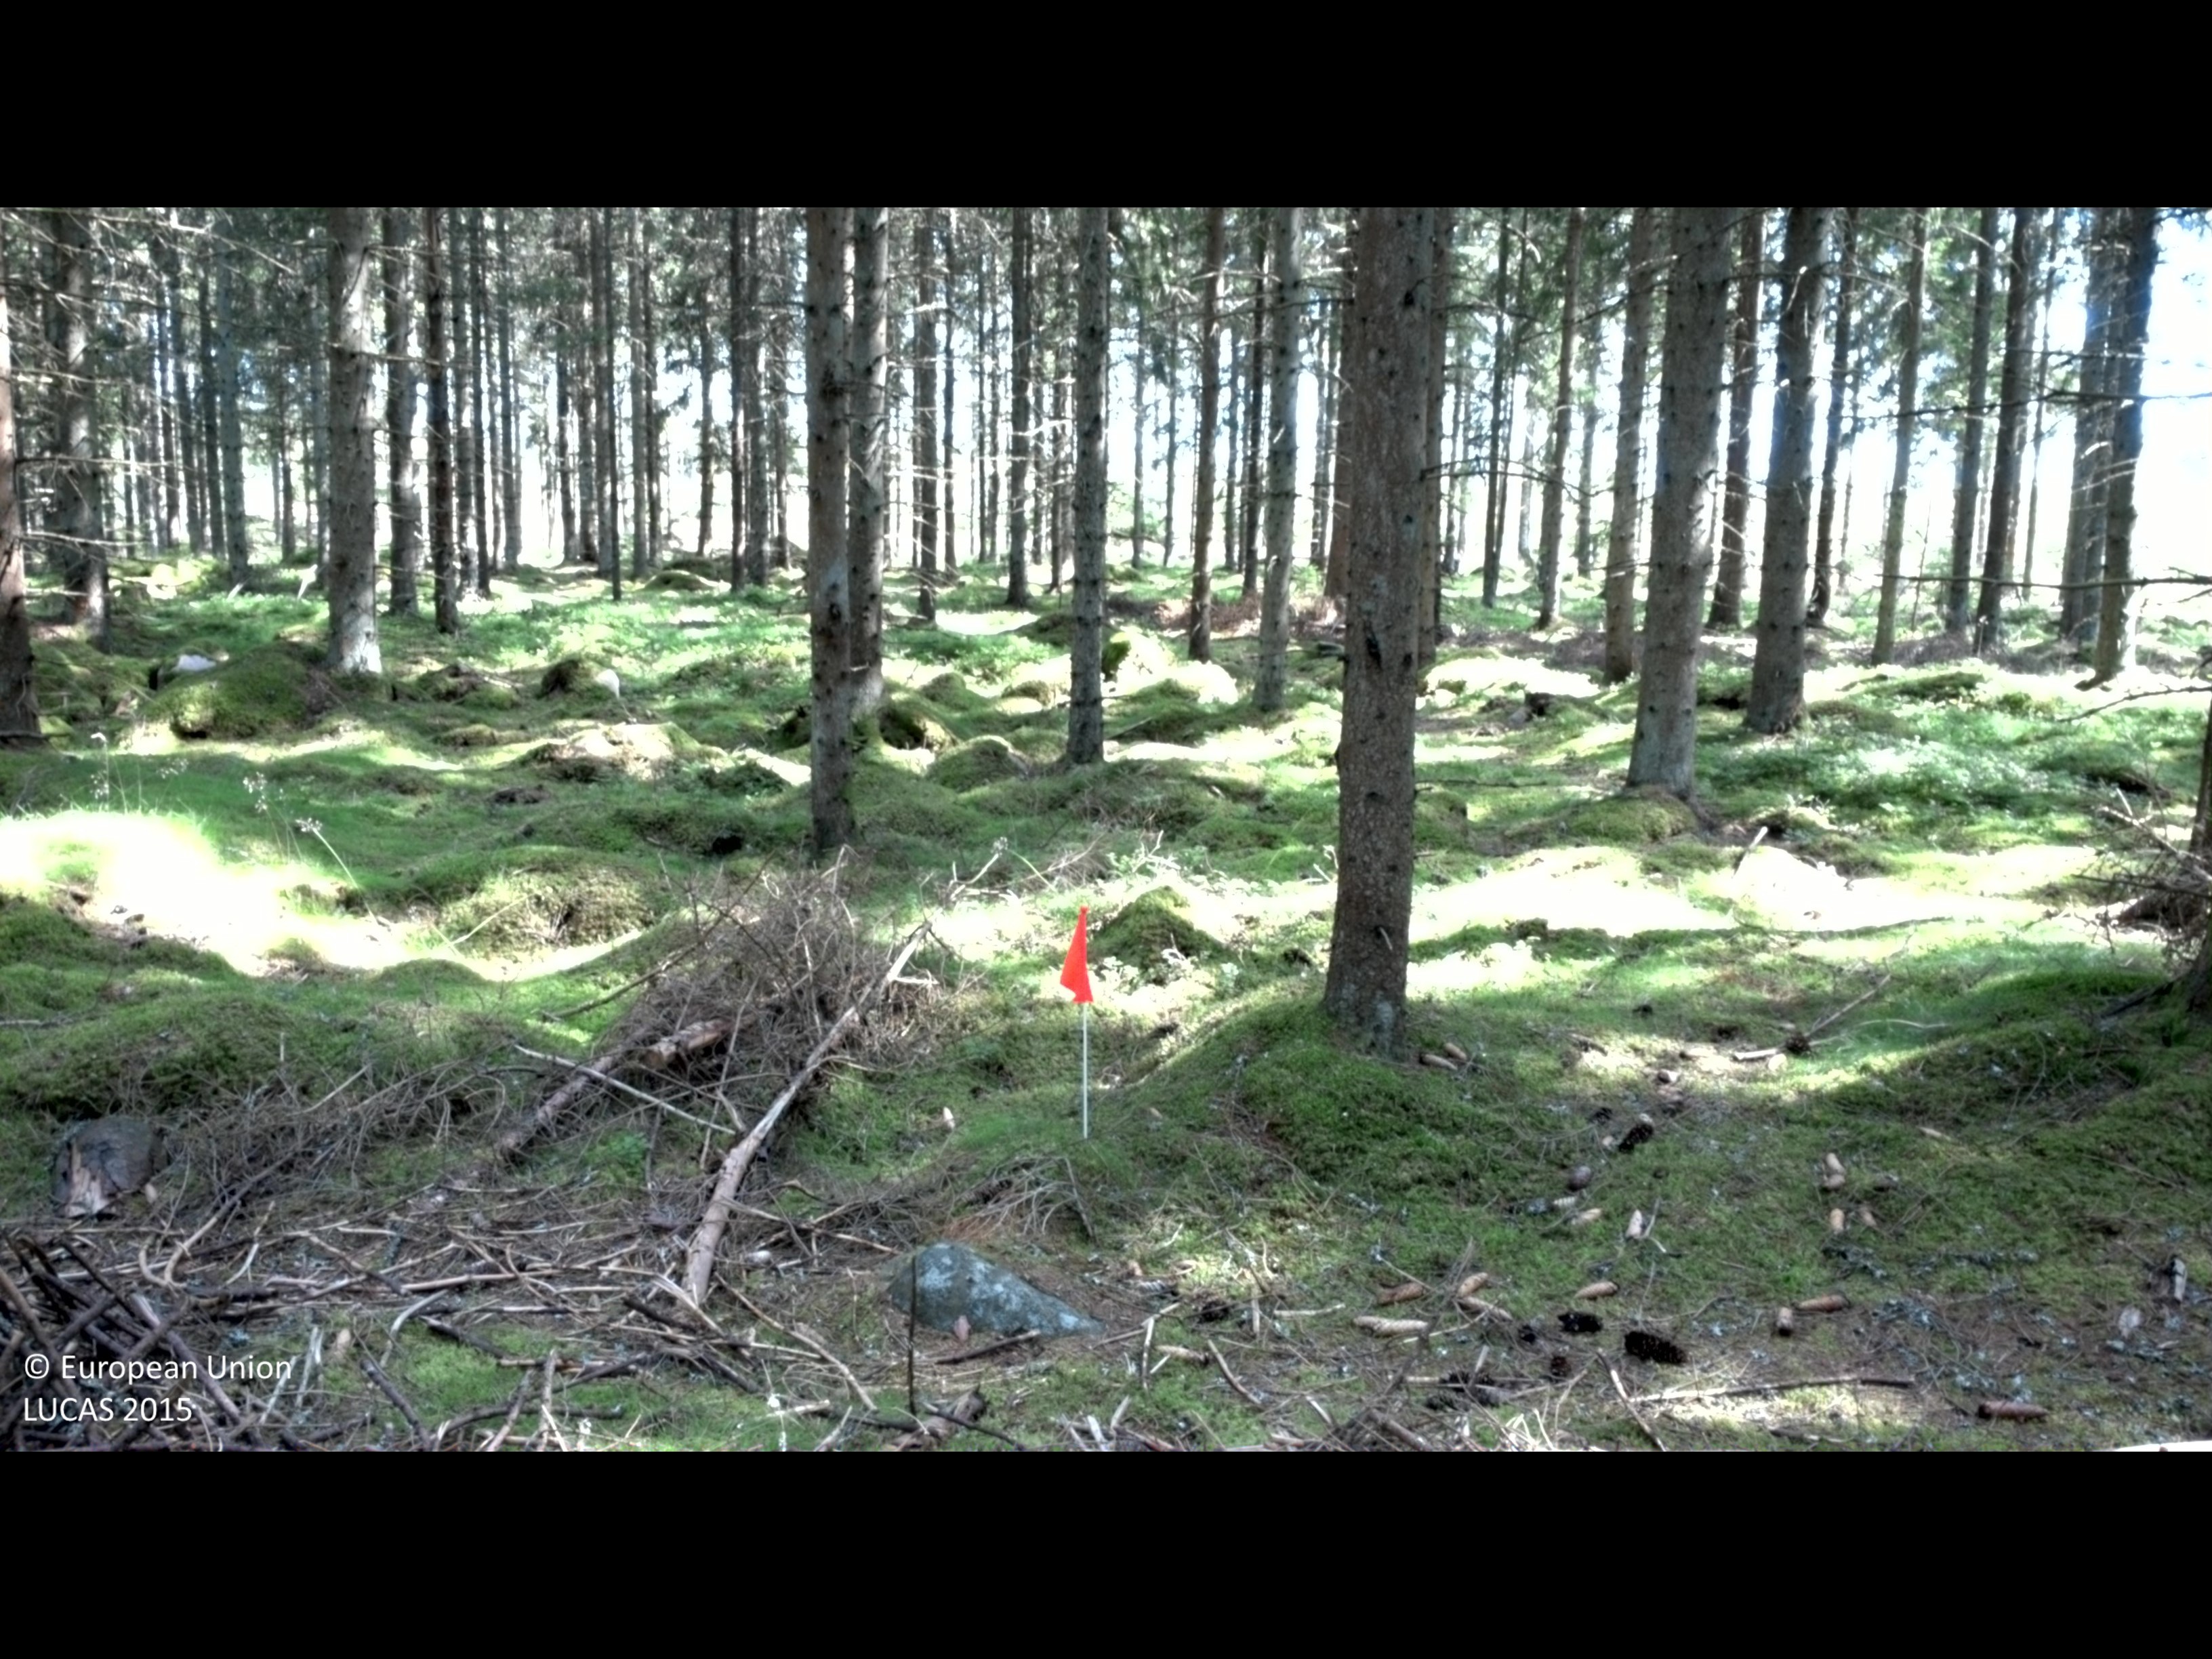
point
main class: Woodland
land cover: Spruce dominated coniferous woodland
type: boreal forest
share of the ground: > 75 %
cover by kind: coniferous forest trees 80 %, lichens and mosses 15 %, shrubs 5 %
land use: Forestry
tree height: > 5 m
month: August
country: SE
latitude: 56.8580
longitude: 14.1787
